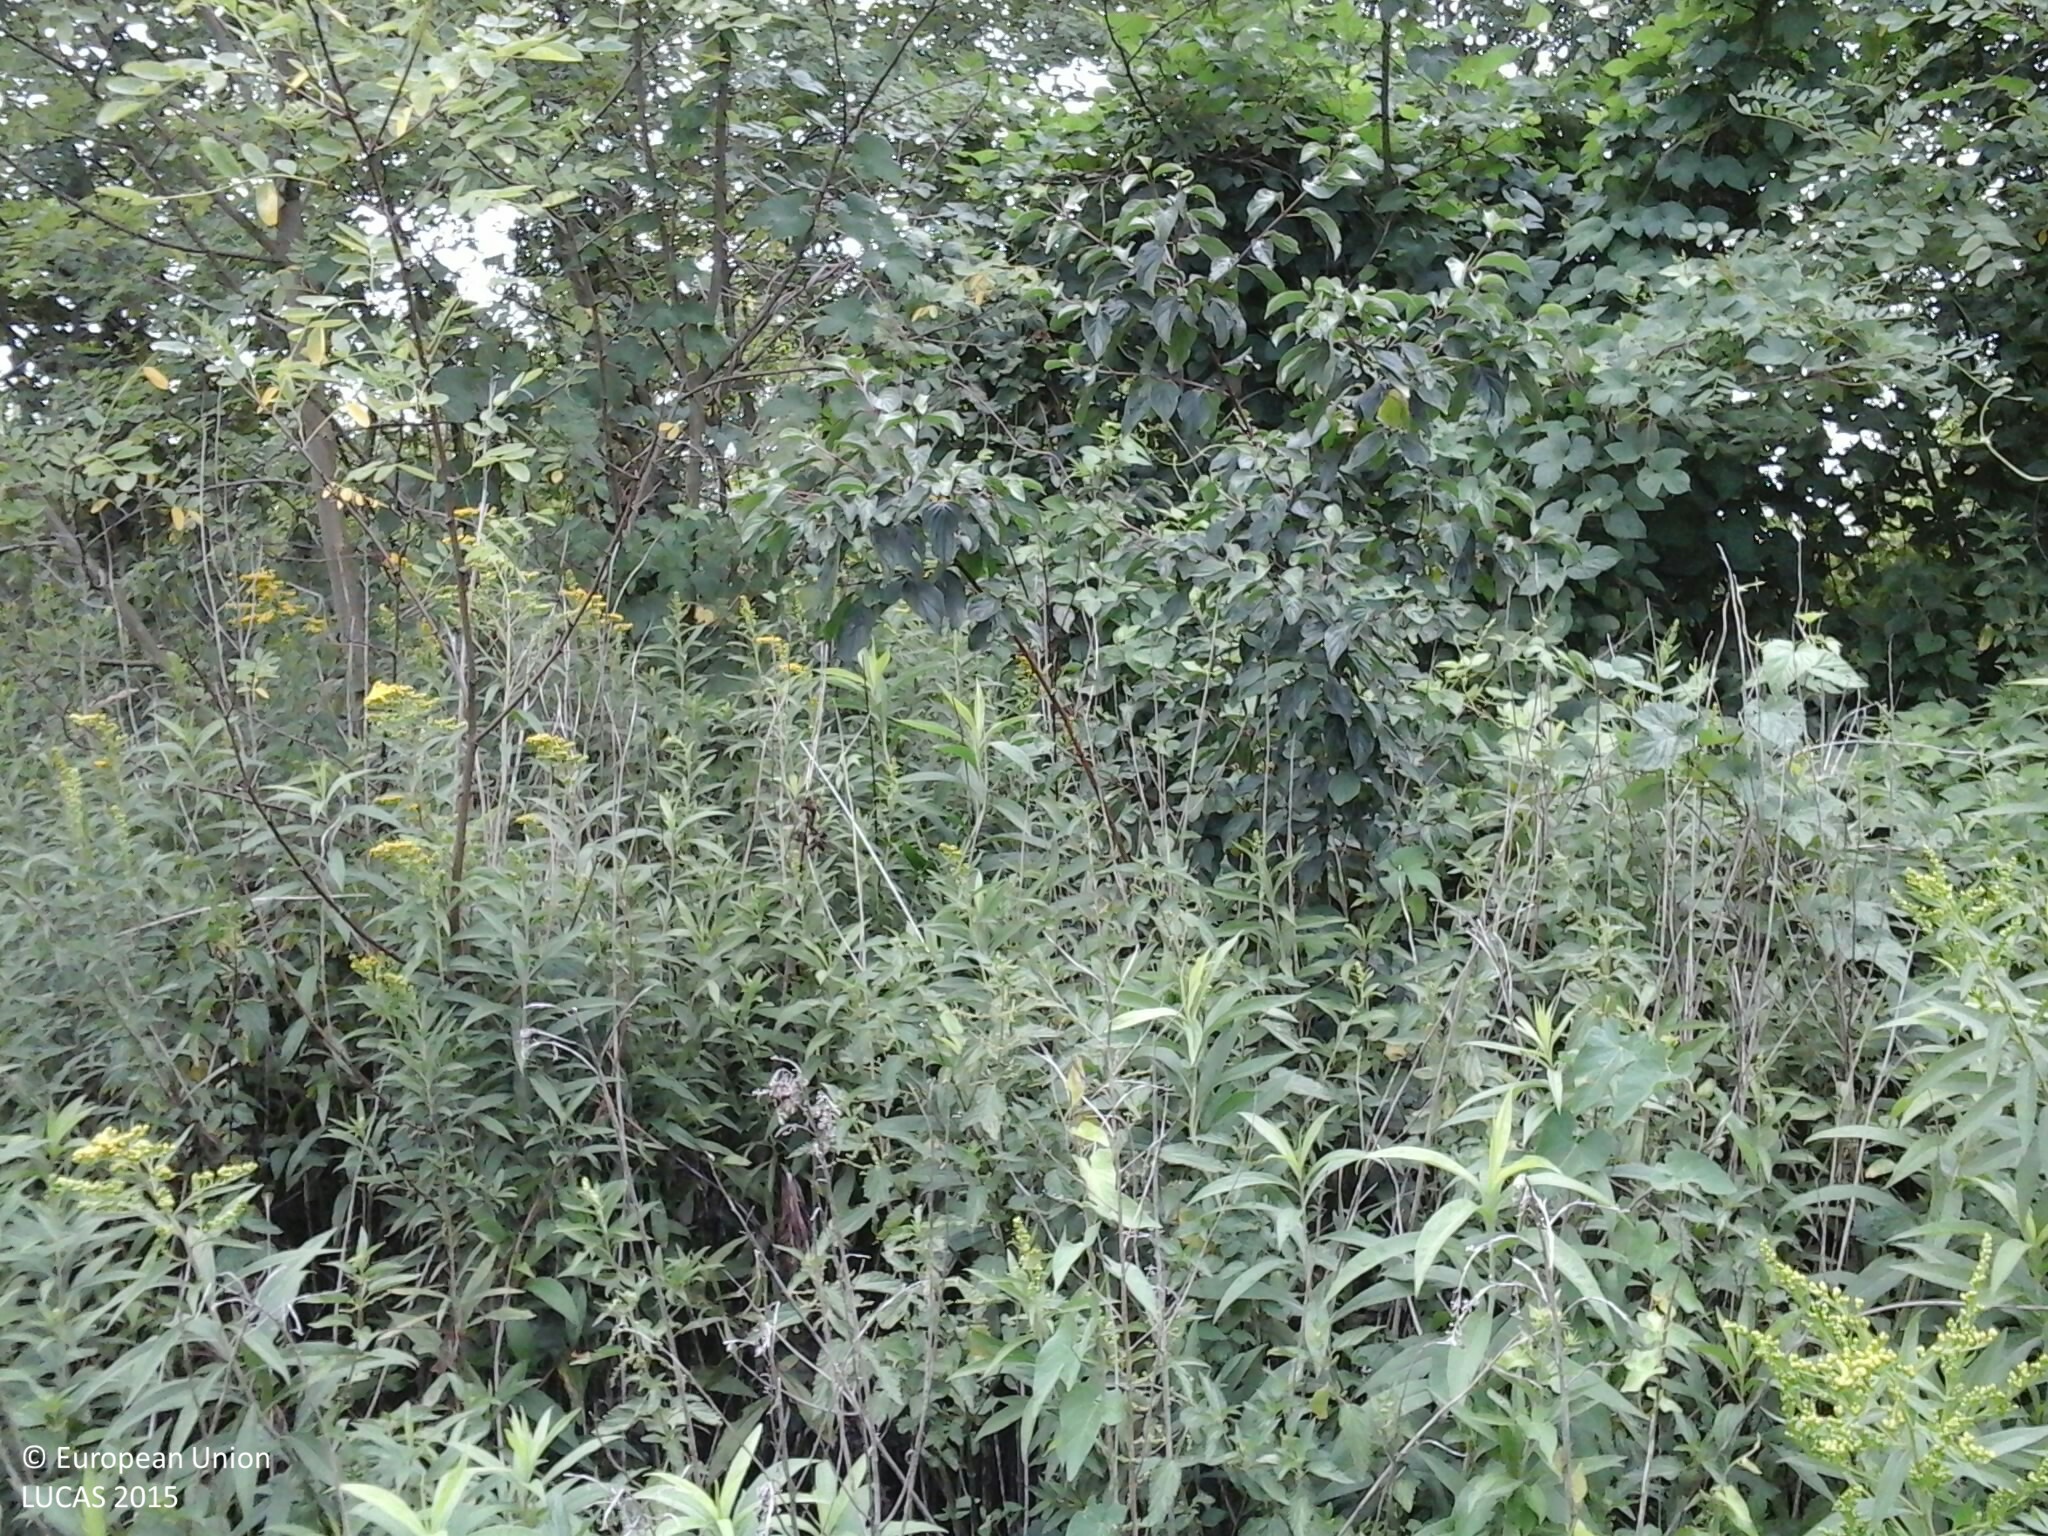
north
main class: Cropland
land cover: Other cereals
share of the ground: > 75 %
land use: Agriculture (excluding fallow land and kitchen gardens)
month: July
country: HU
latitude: 46.6626
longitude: 16.4445
